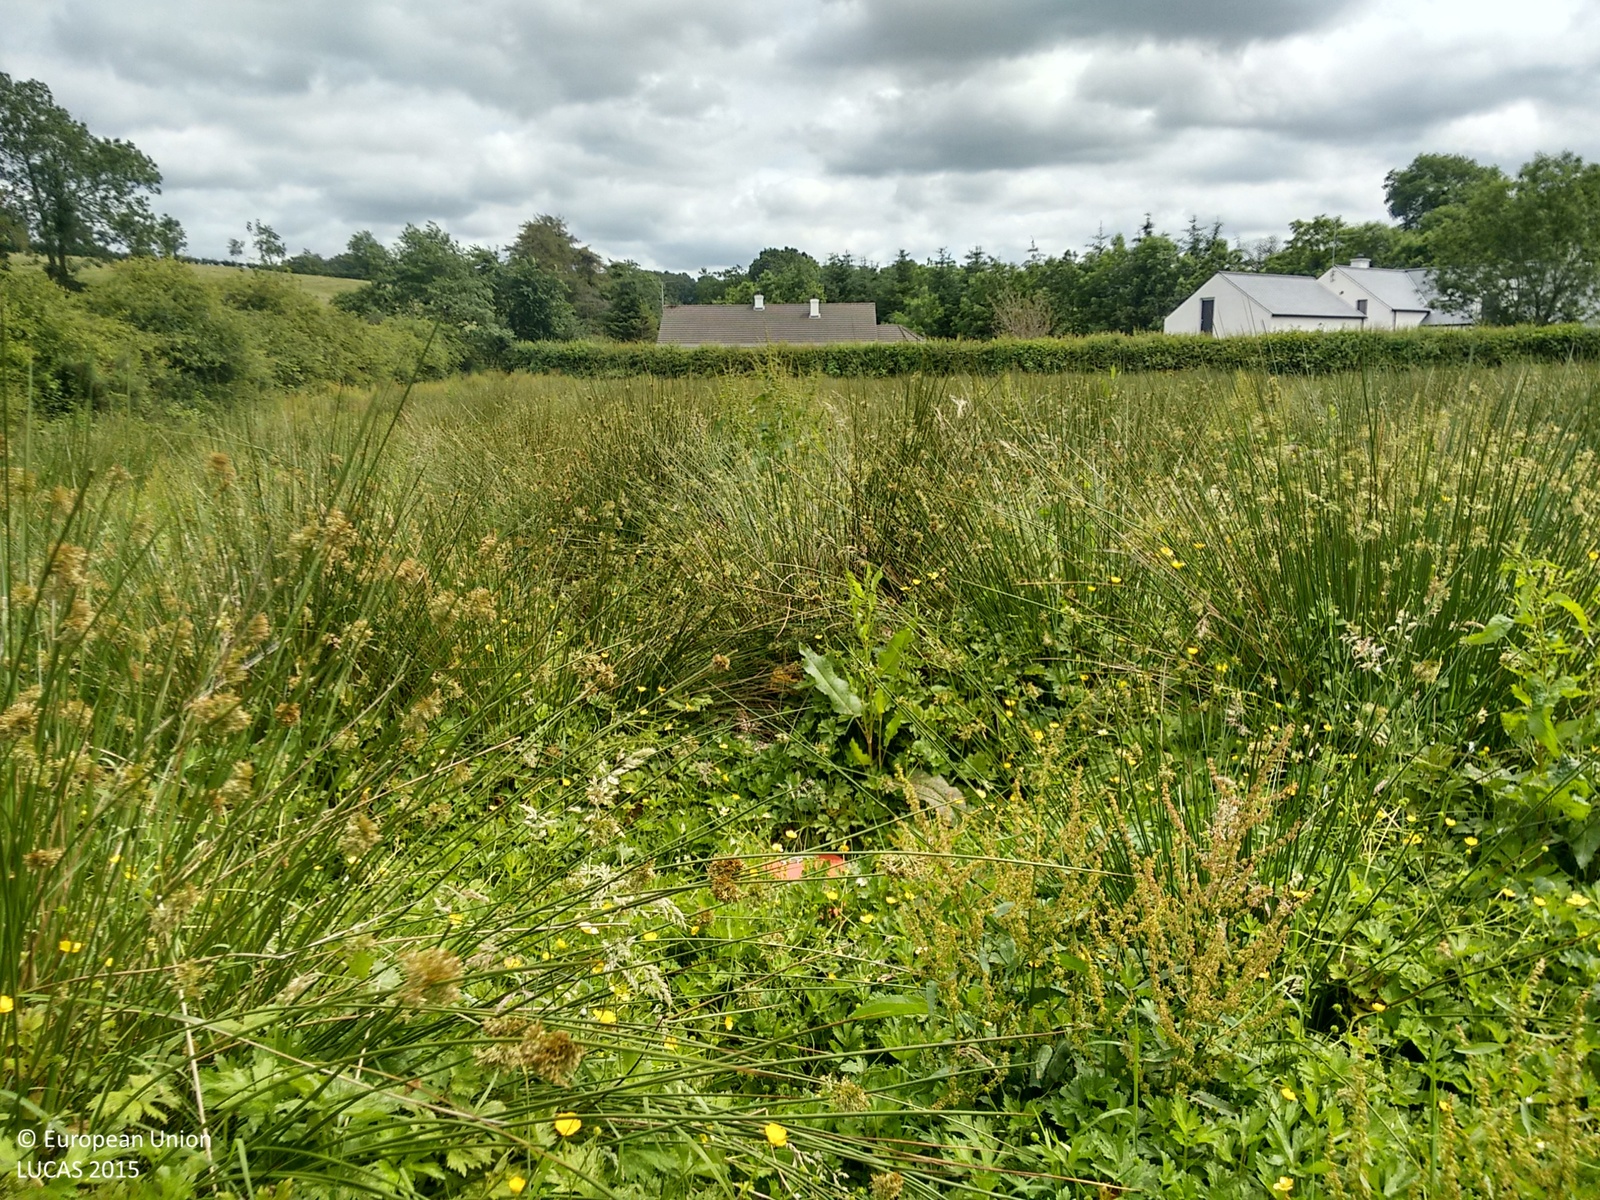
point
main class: Grassland
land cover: Grassland without tree/shrub cover
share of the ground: > 75 %
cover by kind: herbaceous plants 100 %
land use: Agriculture (excluding fallow land and kitchen gardens)
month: July
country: GB
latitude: 54.6303
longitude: -7.2969
